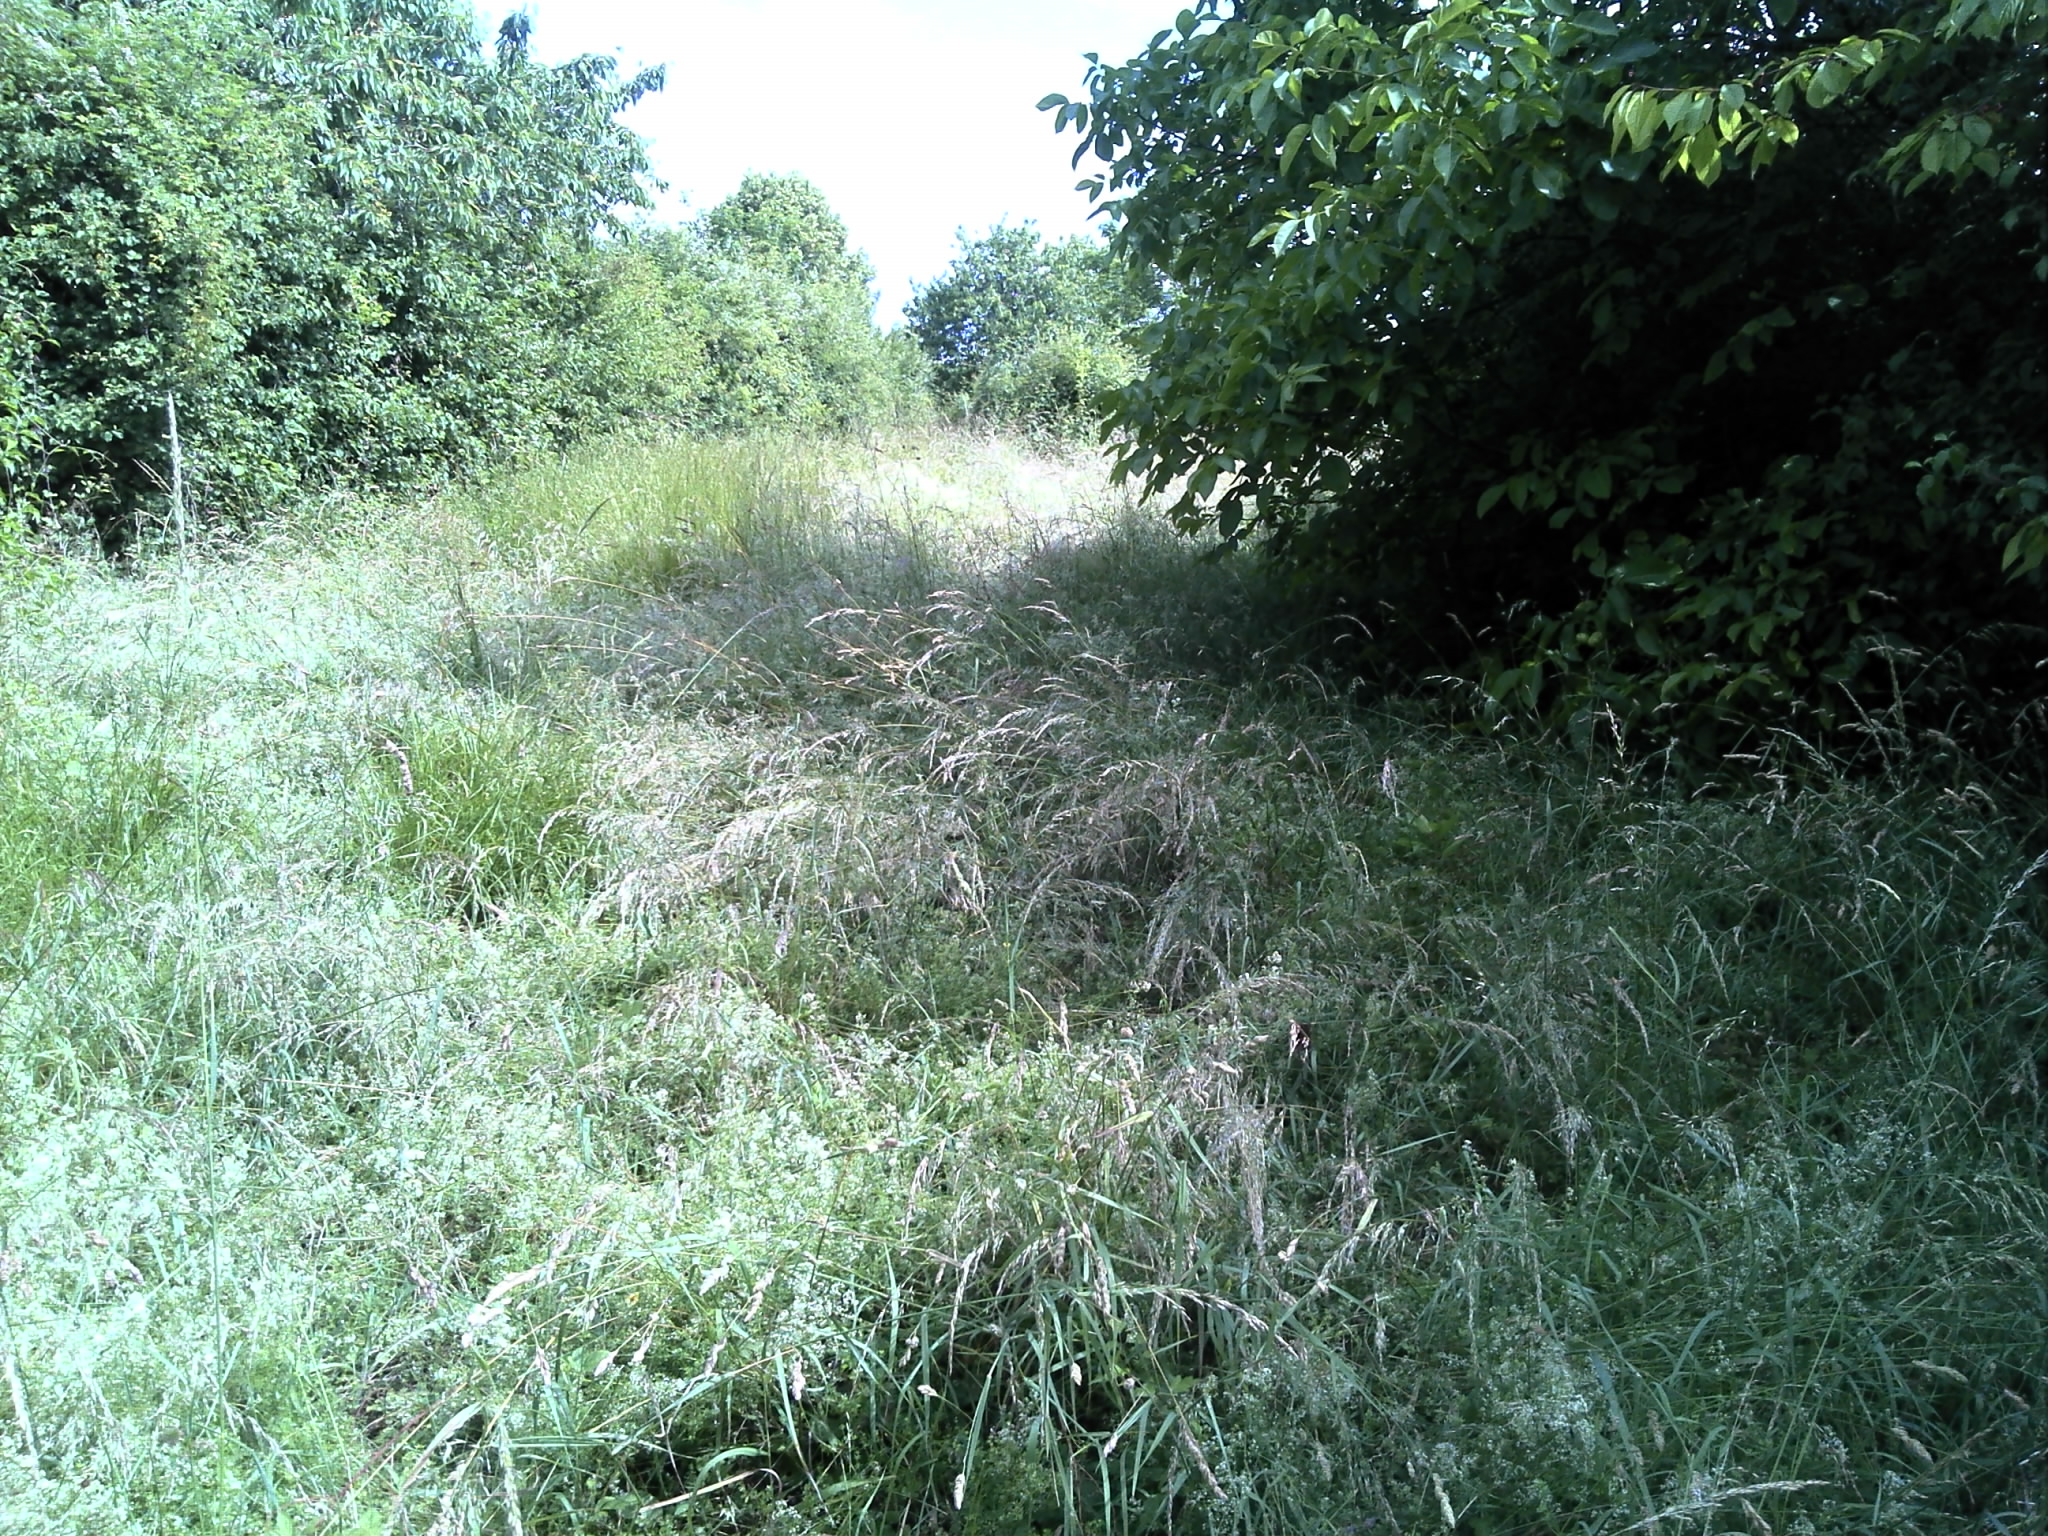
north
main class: Grassland
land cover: Grassland with sparse tree/shrub cover
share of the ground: > 75 %
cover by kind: herbaceous plants 90 %, broadleaved forest trees 5 %, shrubs 5 %
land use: Semi-natural and natural areas not in use
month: June
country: FR
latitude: 47.1775
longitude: 1.5827
